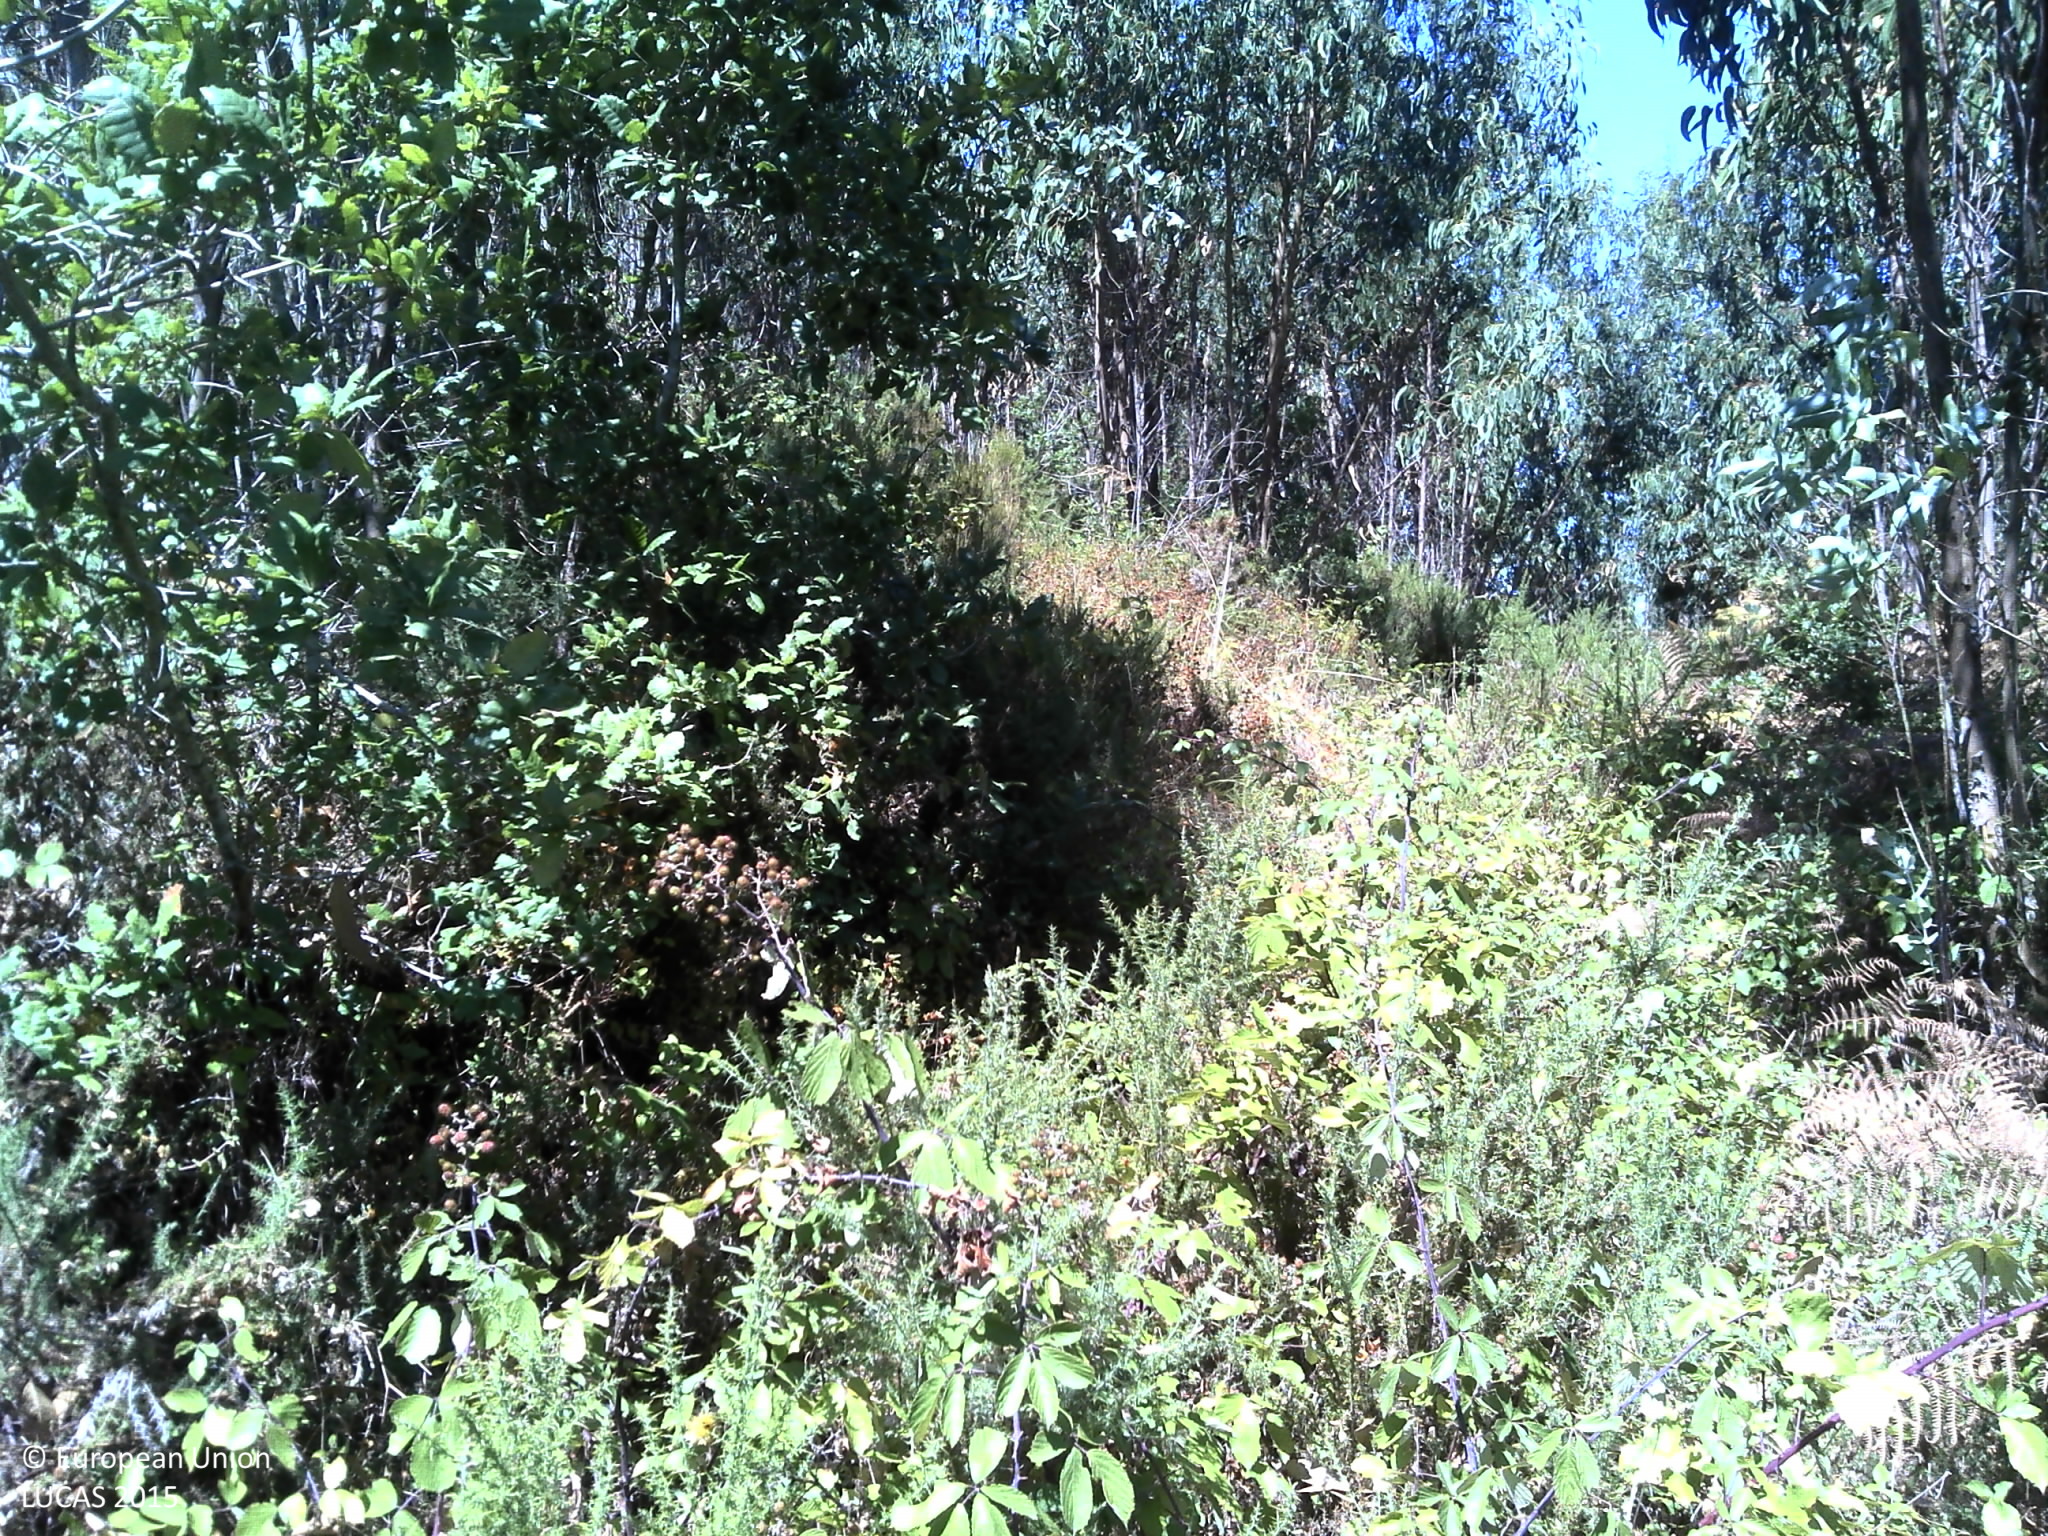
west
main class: Woodland
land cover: Broadleaved woodland
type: exotic forest
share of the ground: 50 - 75 %
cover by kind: broadleaved forest trees 55 %, shrubs 30 %, unconsolidated bare surface 15 %
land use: Forestry
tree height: > 5 m
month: July
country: PT
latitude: 38.9524
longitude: -9.2494
